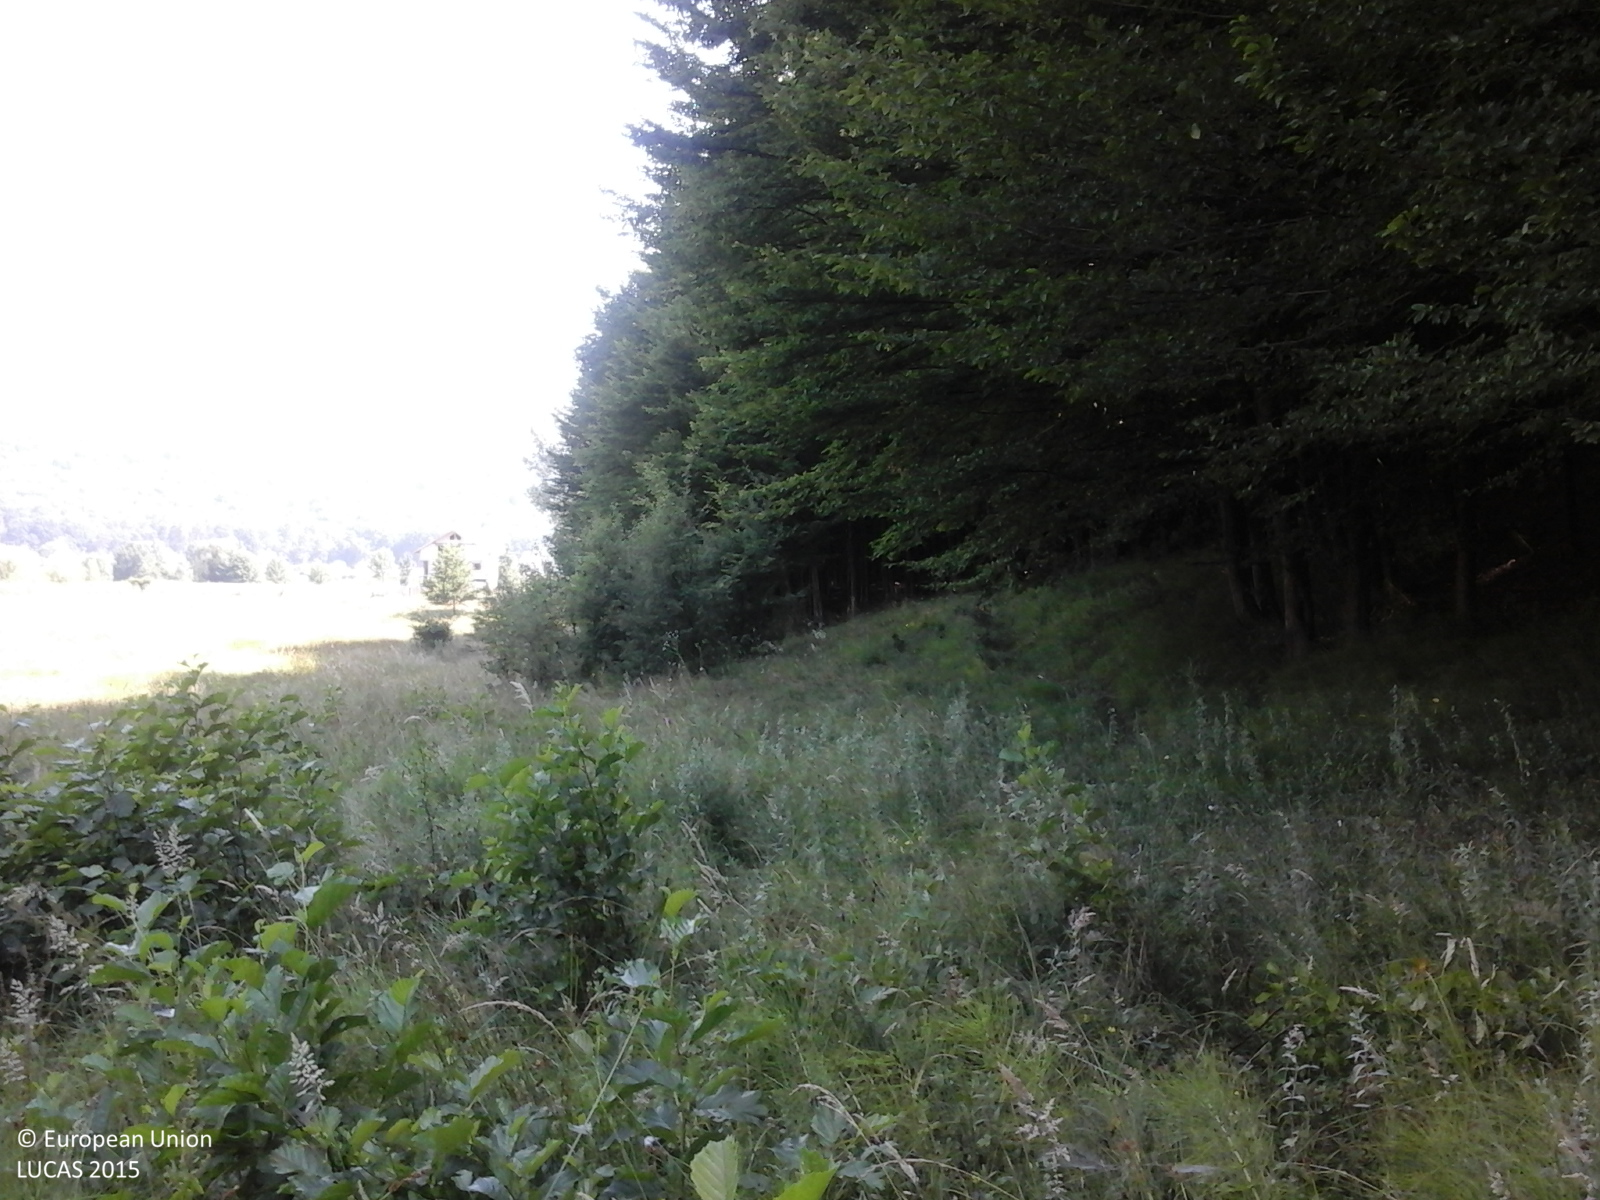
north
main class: Grassland
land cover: Grassland with sparse tree/shrub cover
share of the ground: > 75 %
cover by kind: herbaceous plants 90 %, broadleaved forest trees 5 %, shrubs 5 %
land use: Forestry
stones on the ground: 10 - 25 %
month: July
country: RO
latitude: 44.8786
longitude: 24.7772
